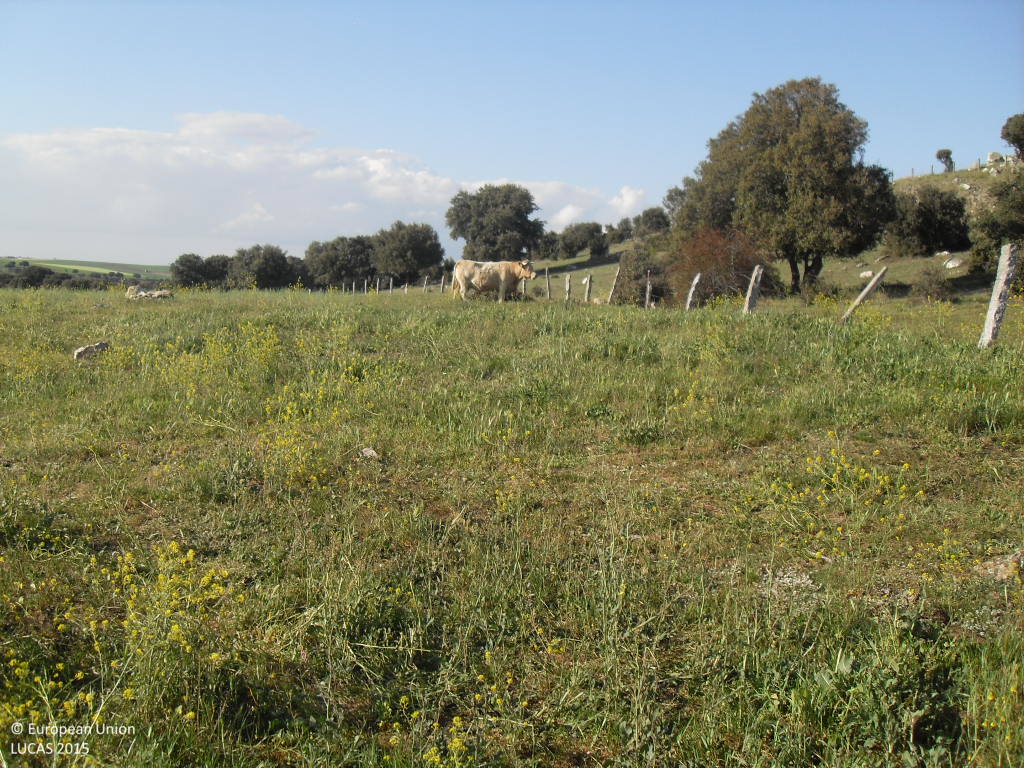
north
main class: Grassland
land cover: Grassland without tree/shrub cover
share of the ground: > 75 %
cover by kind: herbaceous plants 100 %
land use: Agriculture (excluding fallow land and kitchen gardens)
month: April
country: ES
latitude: 40.7125
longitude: -5.3012
